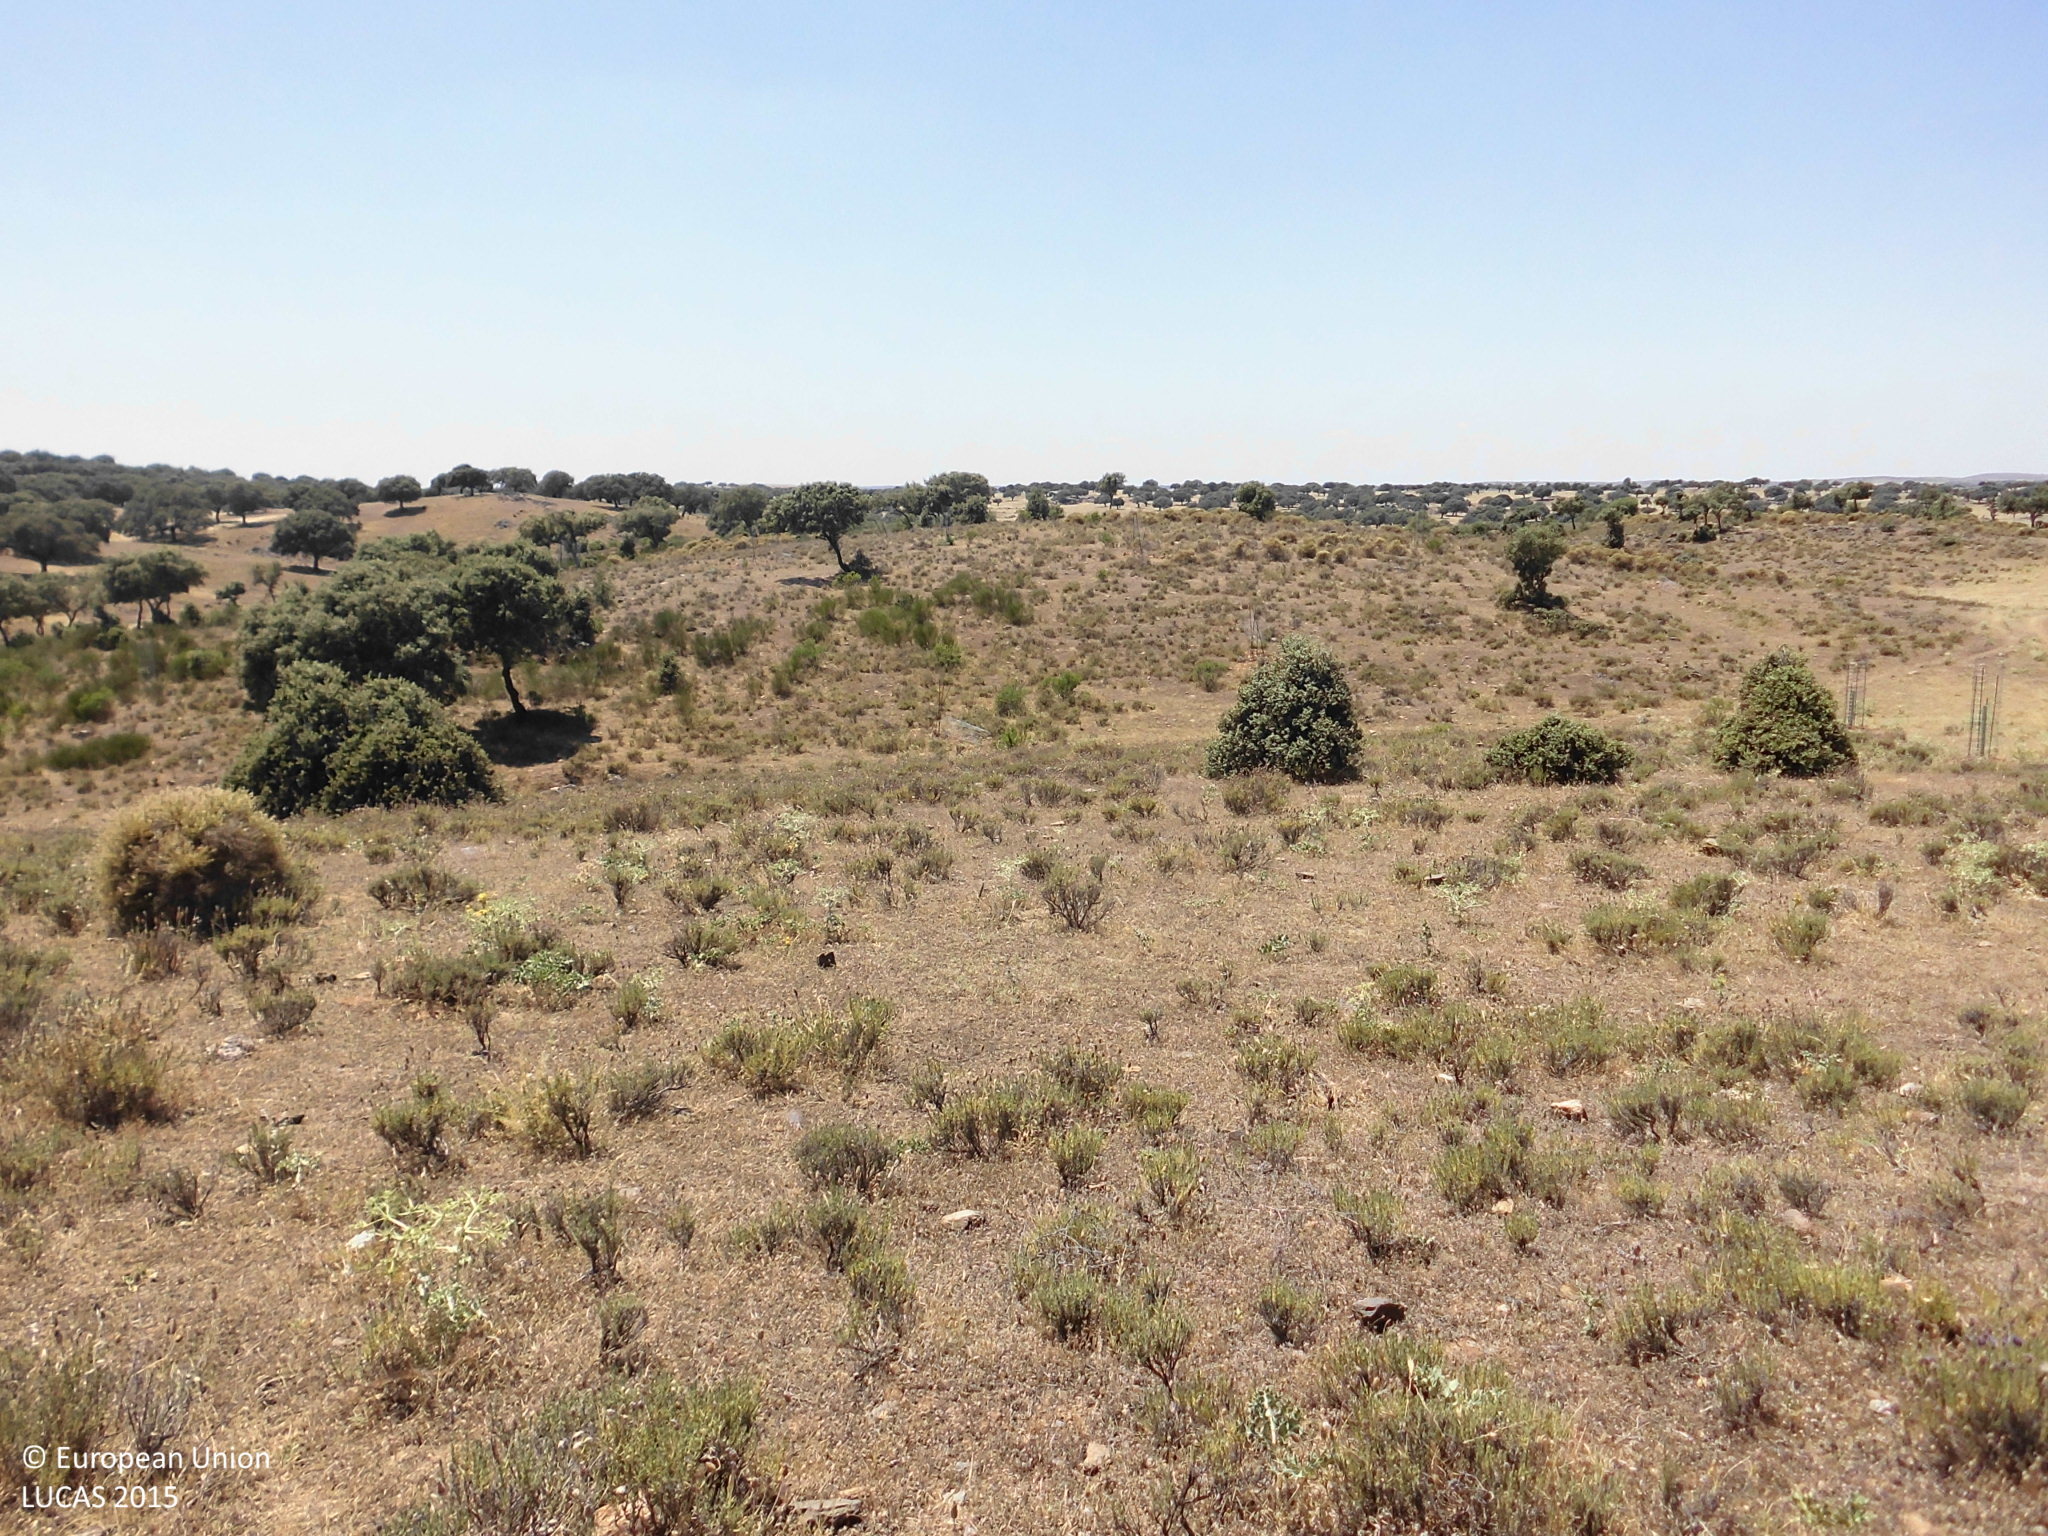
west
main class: Shrubland
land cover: Shrubland with sparse tree cover
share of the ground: 10 - 25 %
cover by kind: herbaceous plants 75 %, shrubs 20 %, broadleaved forest trees 5 %
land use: Agriculture (excluding fallow land and kitchen gardens)
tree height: > 5 m
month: May
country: ES
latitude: 39.8461
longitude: -6.7599
